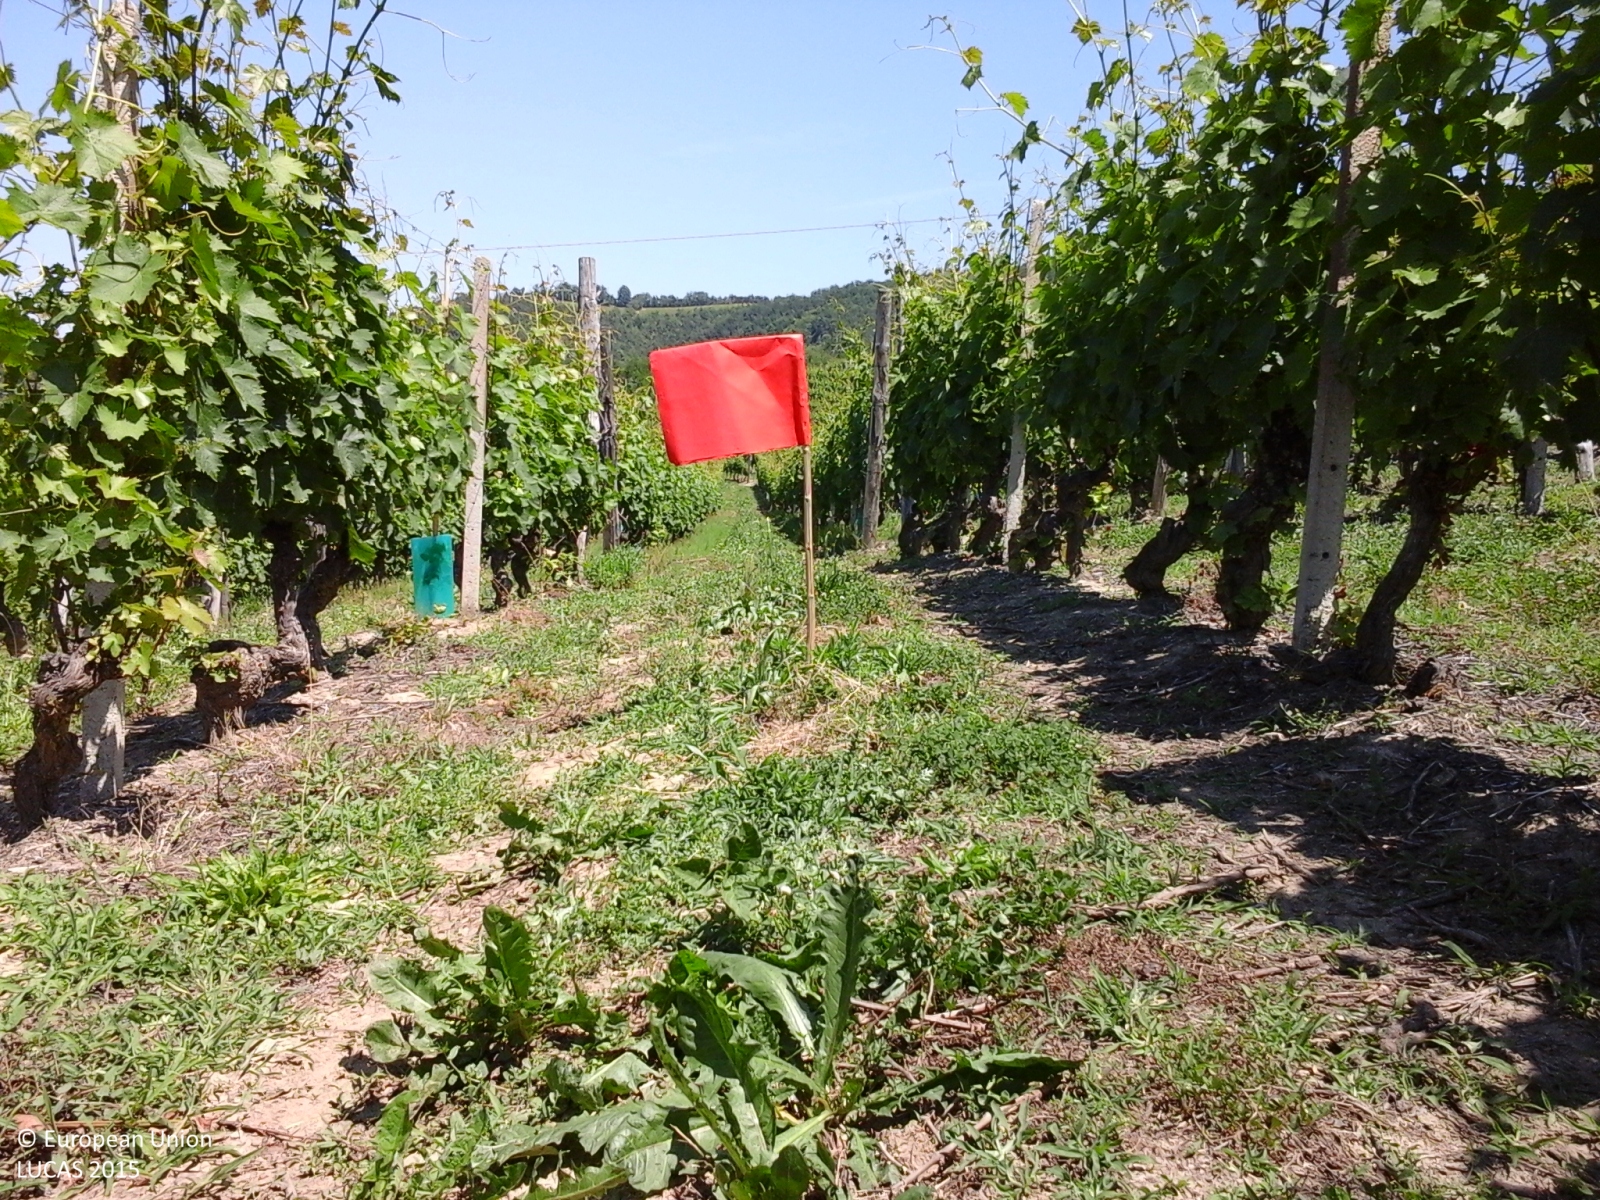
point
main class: Cropland
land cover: Vineyards
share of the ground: 50 - 75 %
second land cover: Grassland without tree/shrub cover
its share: > 75 %
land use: Agriculture (excluding fallow land and kitchen gardens)
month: June
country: IT
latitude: 44.6245
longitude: 8.2517
